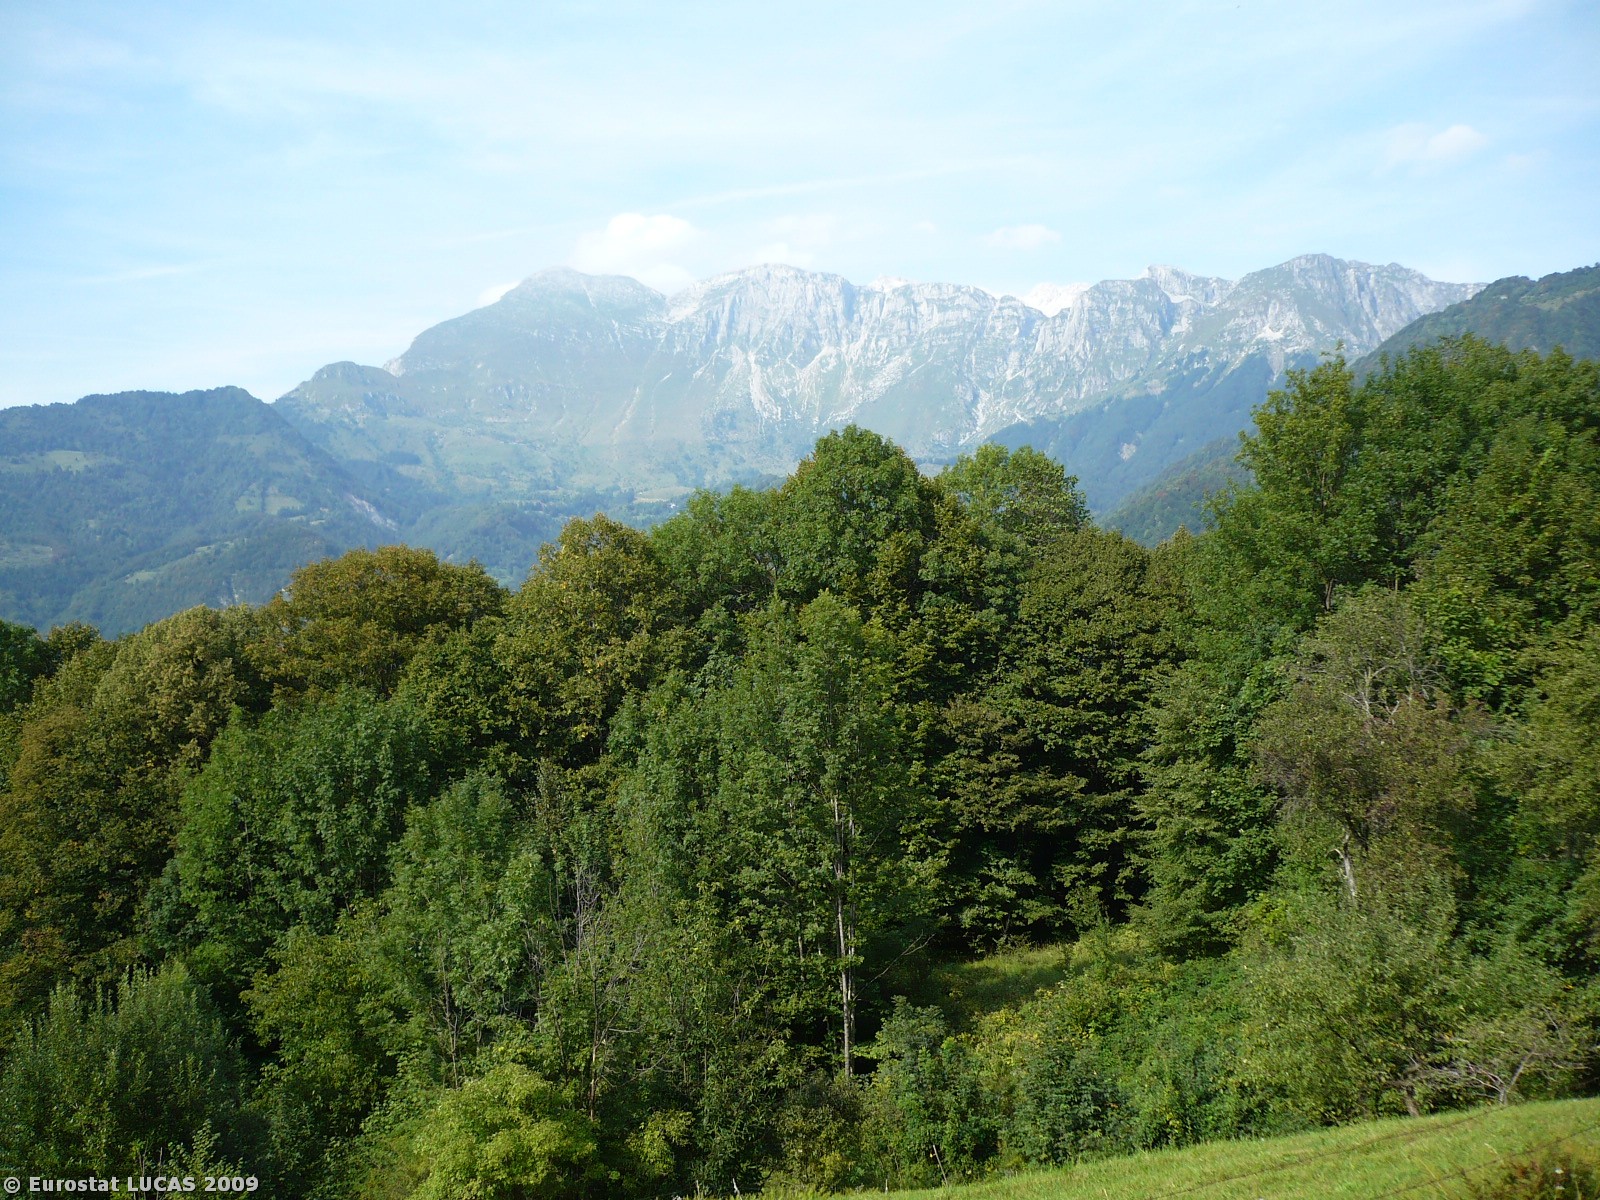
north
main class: Grassland
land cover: Grassland without tree/shrub cover
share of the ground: > 75 %
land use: Agriculture (excluding fallow land and kitchen gardens)
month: August
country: SI
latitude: 46.1983
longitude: 13.6639
